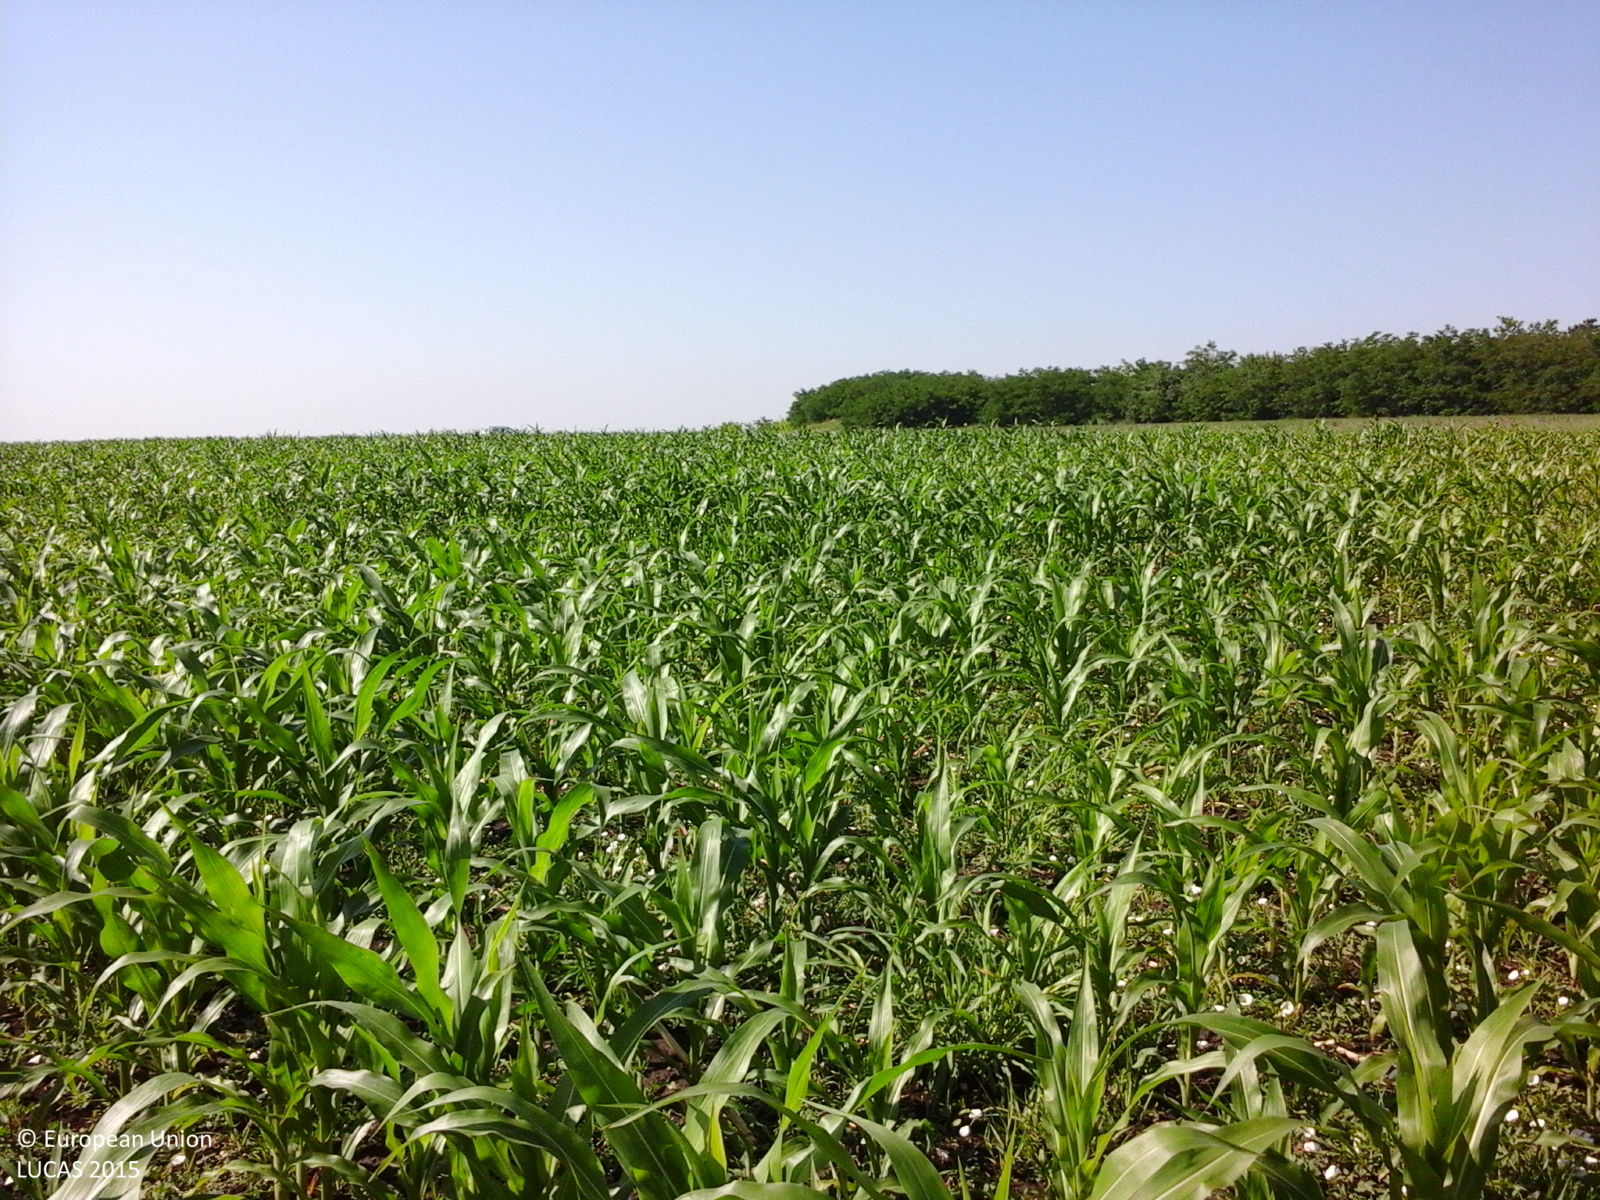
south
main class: Cropland
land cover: Maize
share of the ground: 50 - 75 %
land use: Agriculture (excluding fallow land and kitchen gardens)
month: June
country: RO
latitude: 47.5641
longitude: 27.2708
